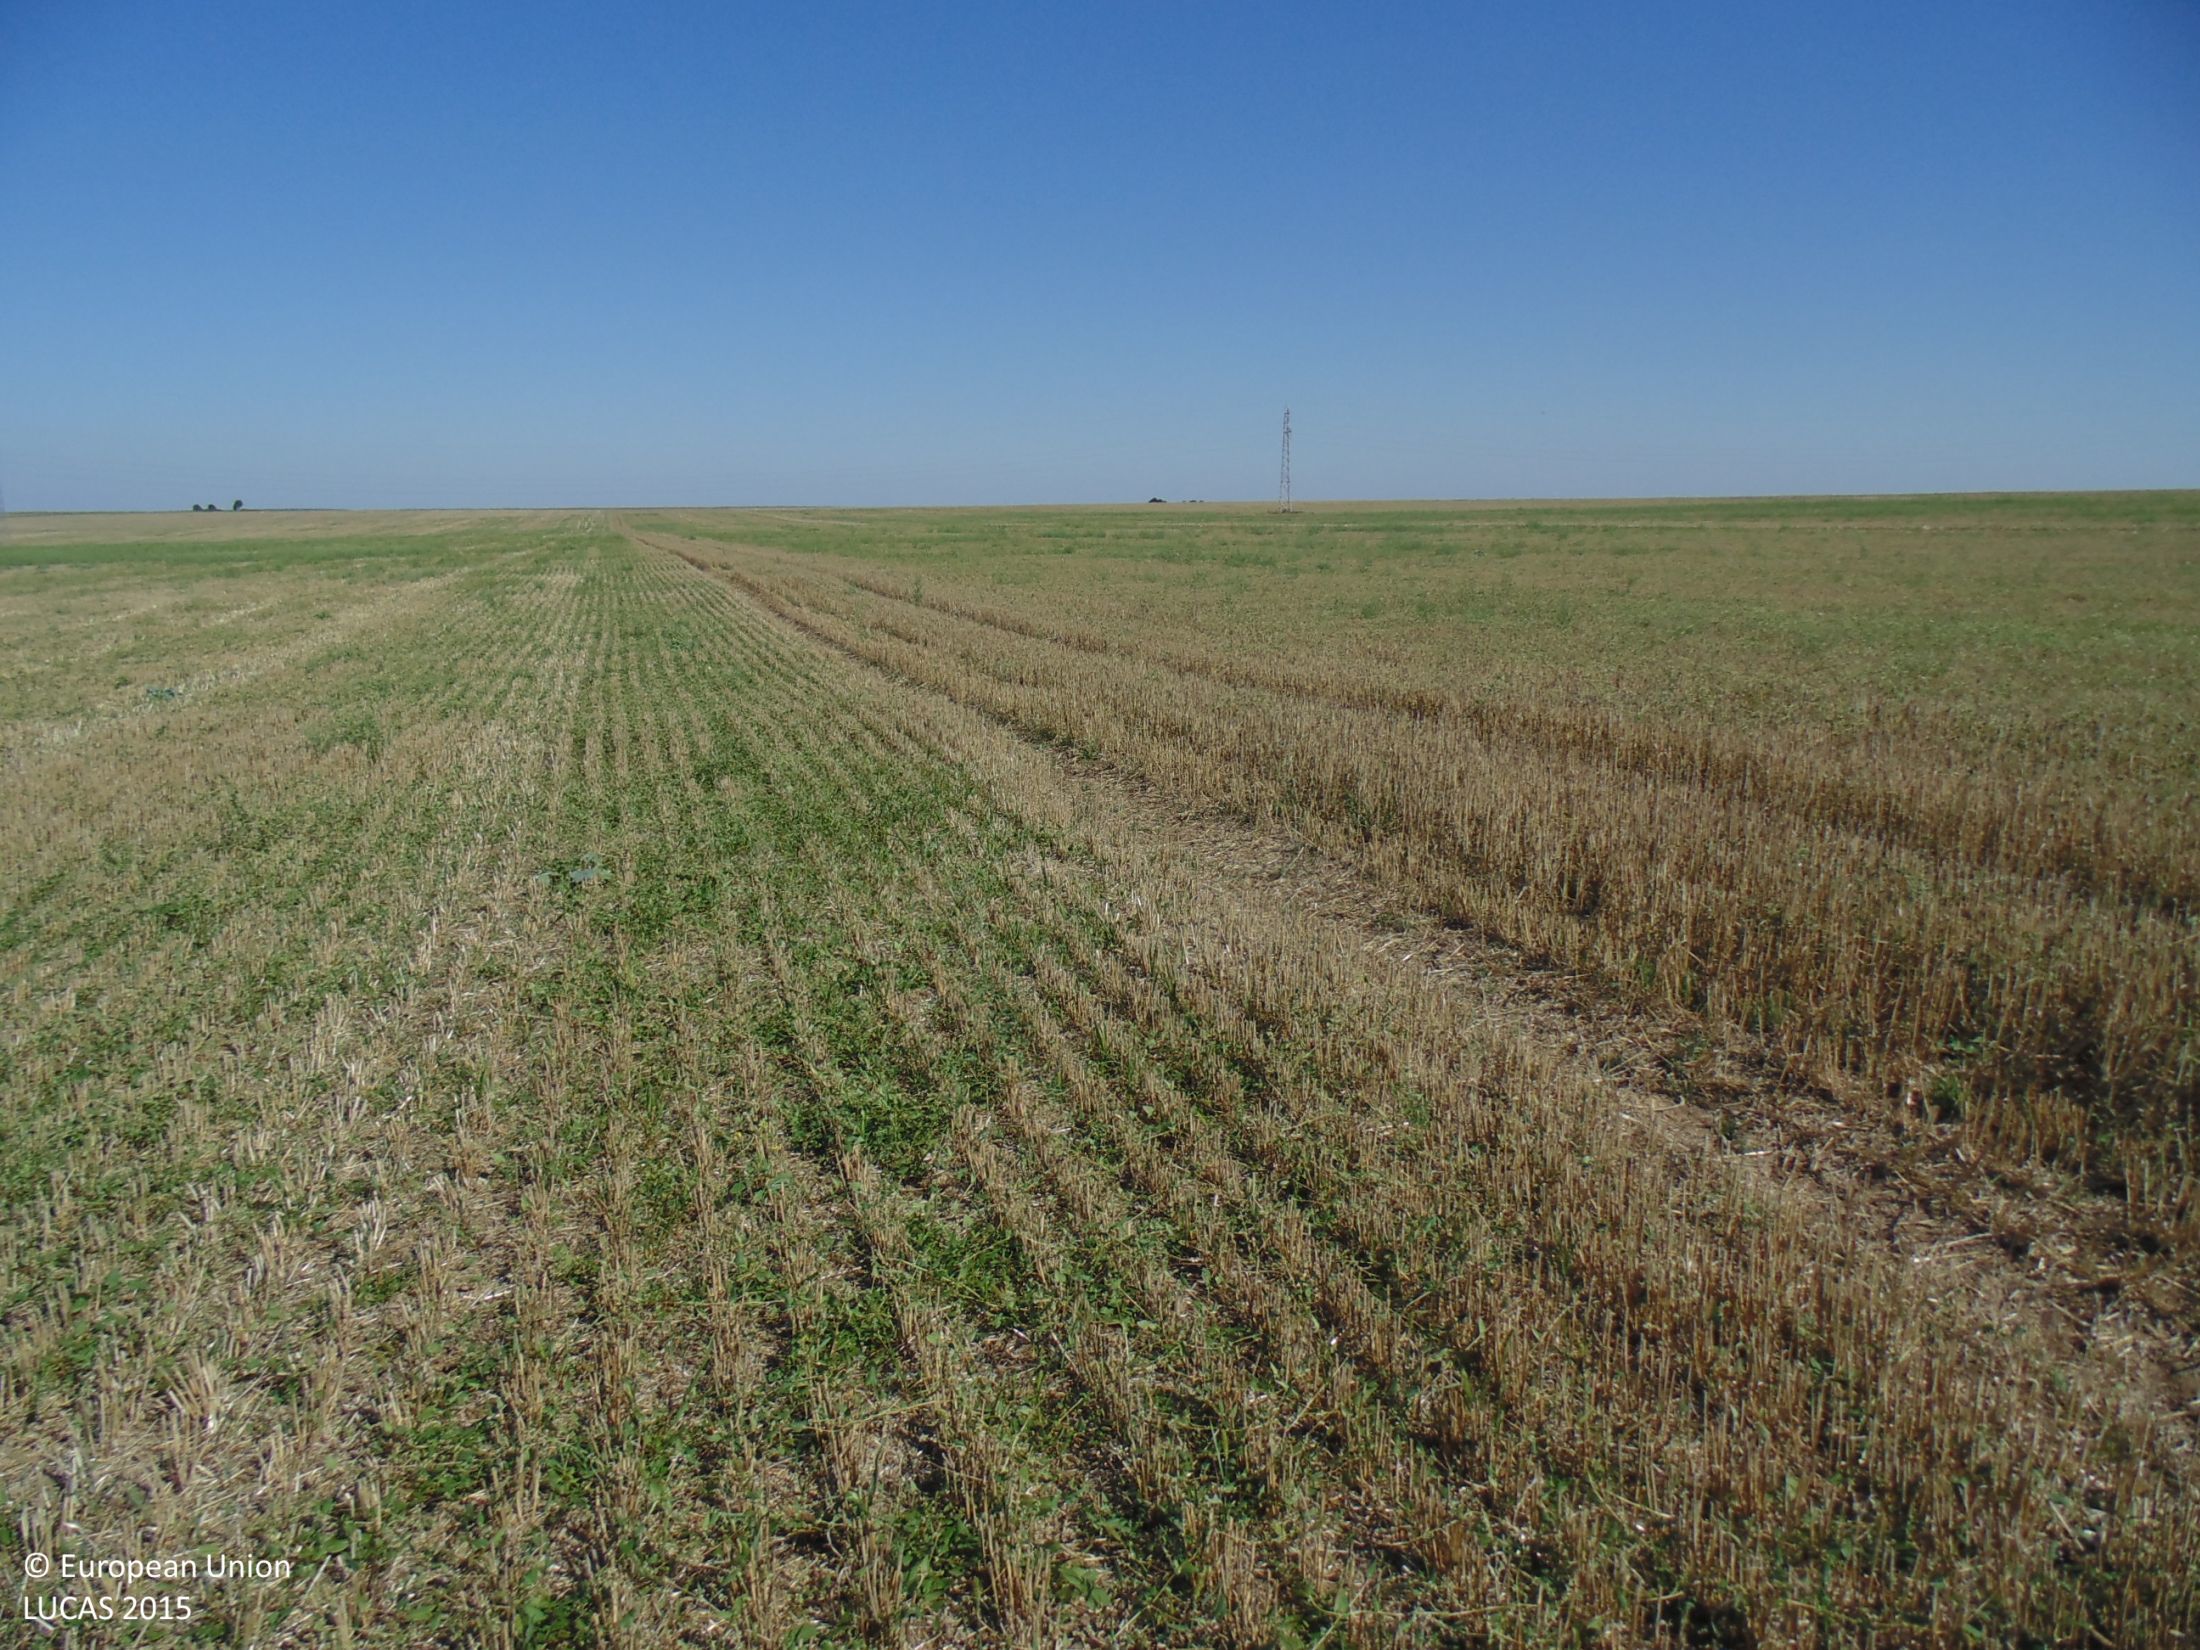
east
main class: Cropland
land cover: Common wheat
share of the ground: 50 - 75 %
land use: Agriculture (excluding fallow land and kitchen gardens)
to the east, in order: Common wheat
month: September
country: BG
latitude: 43.7561
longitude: 27.1525
